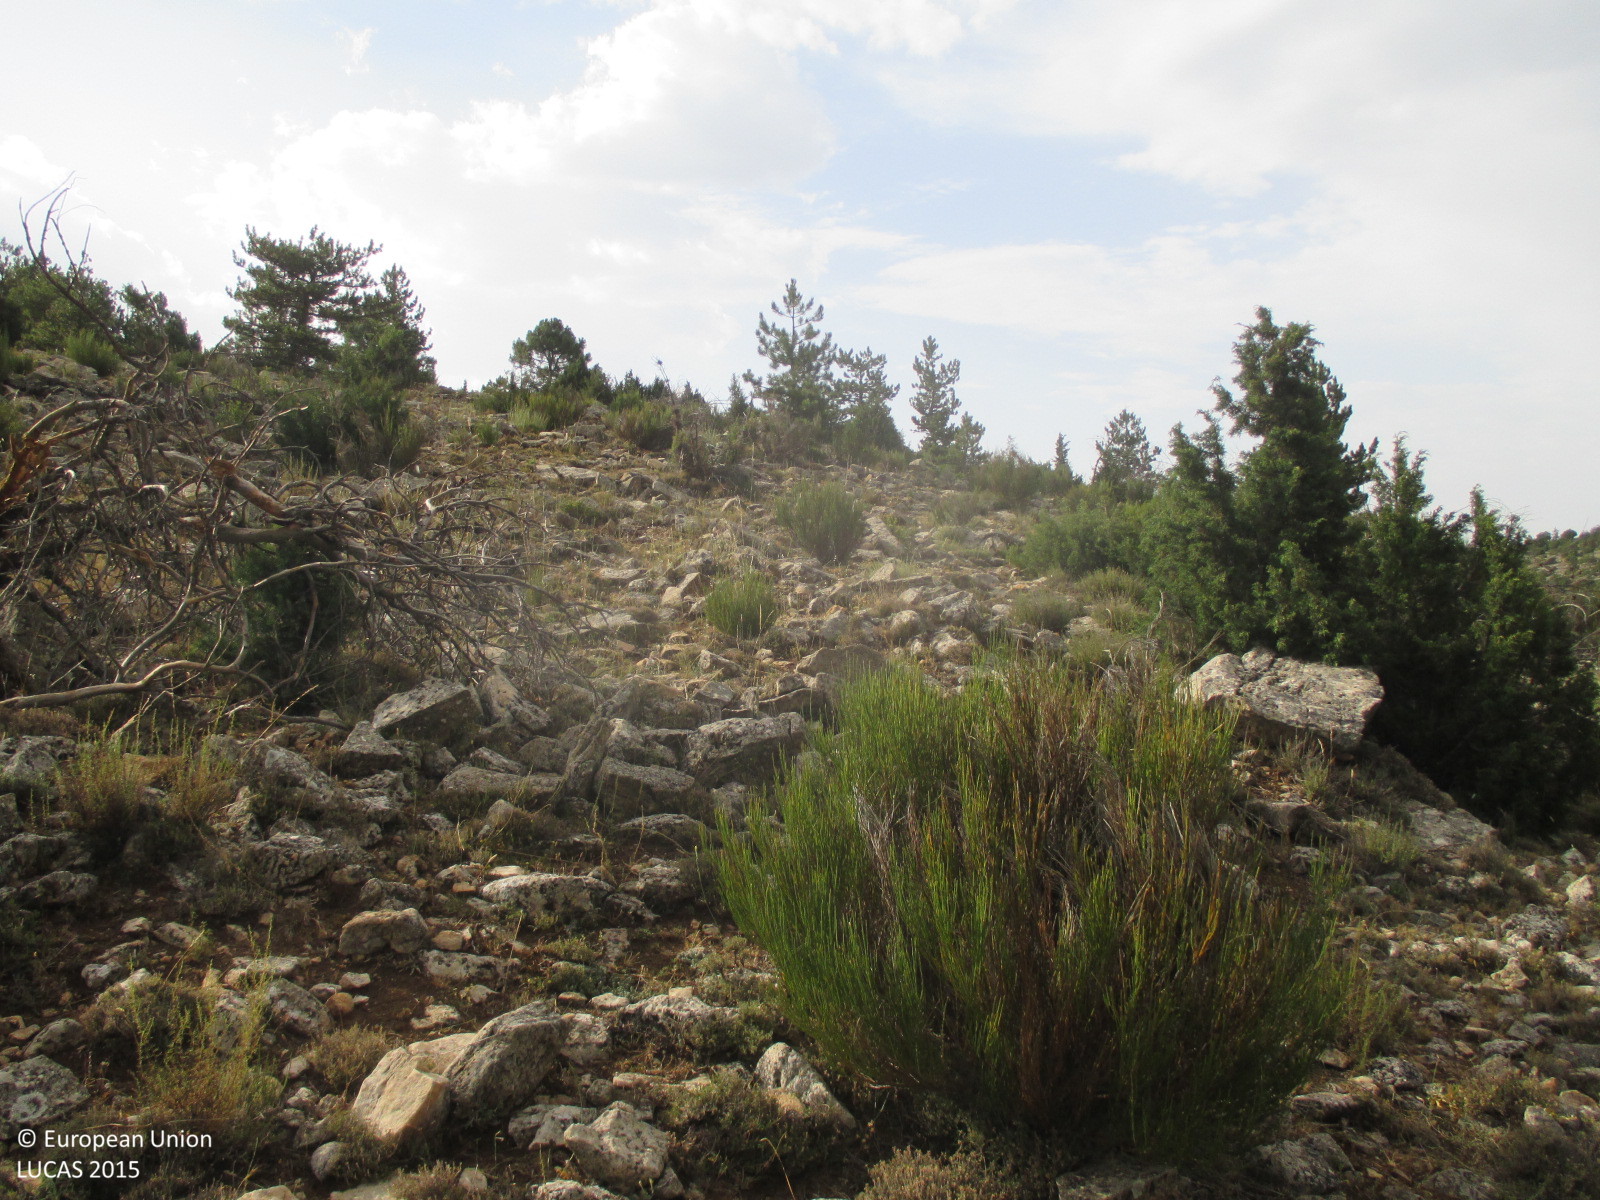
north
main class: Shrubland
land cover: Shrubland with sparse tree cover
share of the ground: 50 - 75 %
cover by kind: shrubs 60 %, herbaceous plants 35 %, coniferous forest trees 5 %
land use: Semi-natural and natural areas not in use
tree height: < 5 m
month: July
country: ES
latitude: 38.1571
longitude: -2.4219
